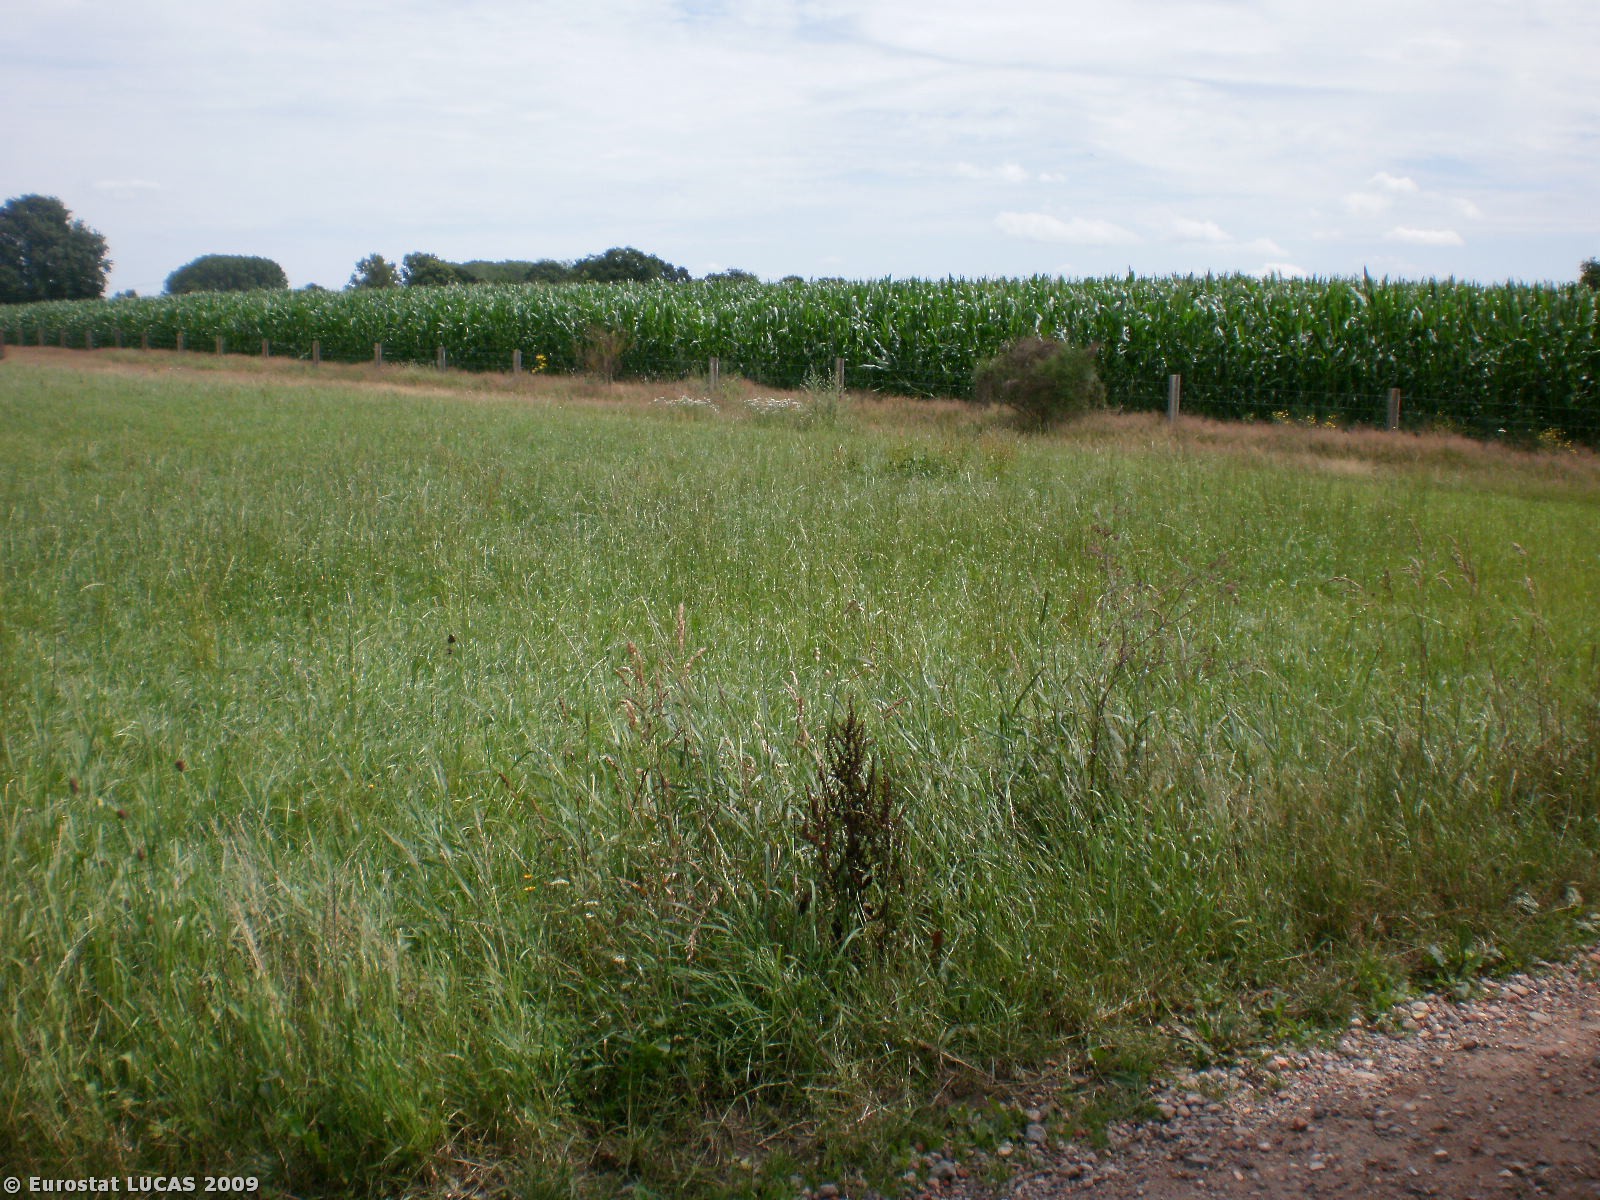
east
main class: Grassland
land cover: Grassland without tree/shrub cover
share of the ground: > 75 %
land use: Agriculture (excluding fallow land and kitchen gardens)
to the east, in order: Grassland without tree/shrub cover; Fences; Grass margins; Lines of trees; Shruby margins; Tracks; Grassland without tree/shrub cover; Tracks; Fences; Grass margins; Maize; Grass margins; Fences; Grassland without tree/shrub cover
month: July
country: BE
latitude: 51.1196
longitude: 5.4406
